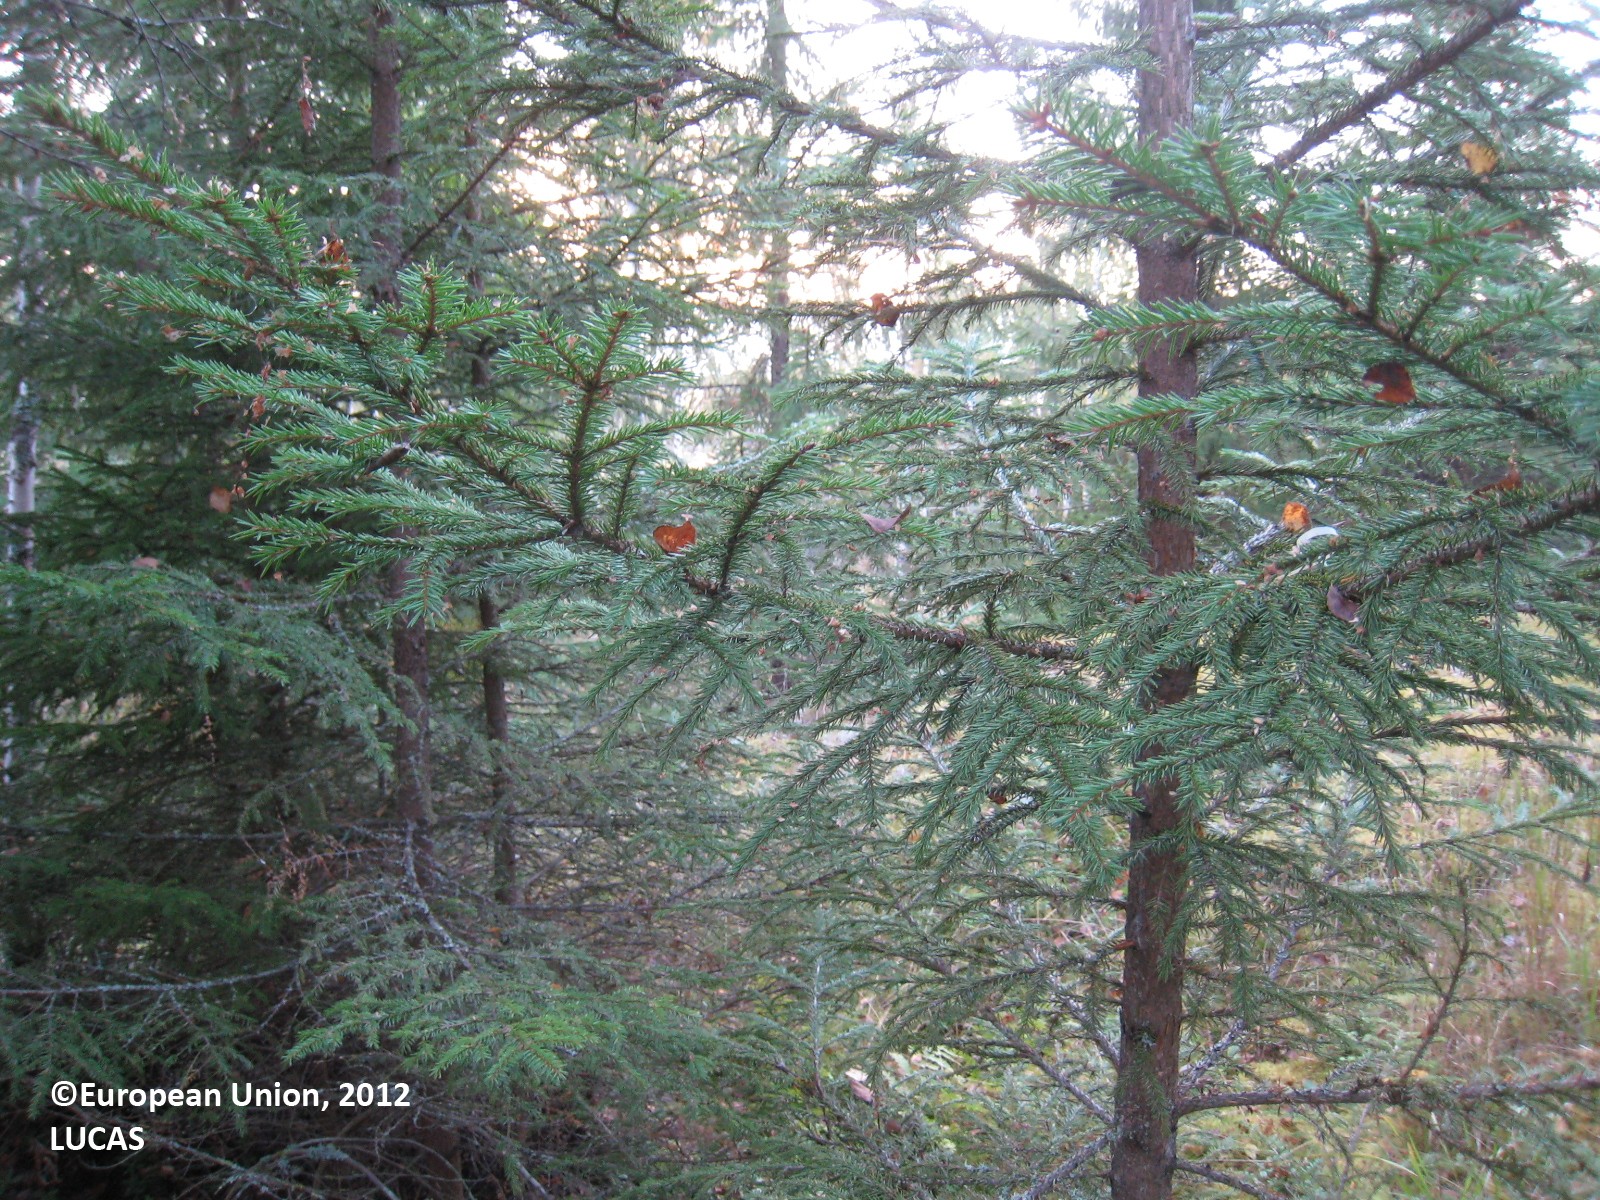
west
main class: Woodland
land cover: Spruce dominated mixed woodland
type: boreal forest
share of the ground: 50 - 75 %
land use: Forestry
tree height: > 5 m
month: September
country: FI
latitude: 62.6403
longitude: 26.4600
